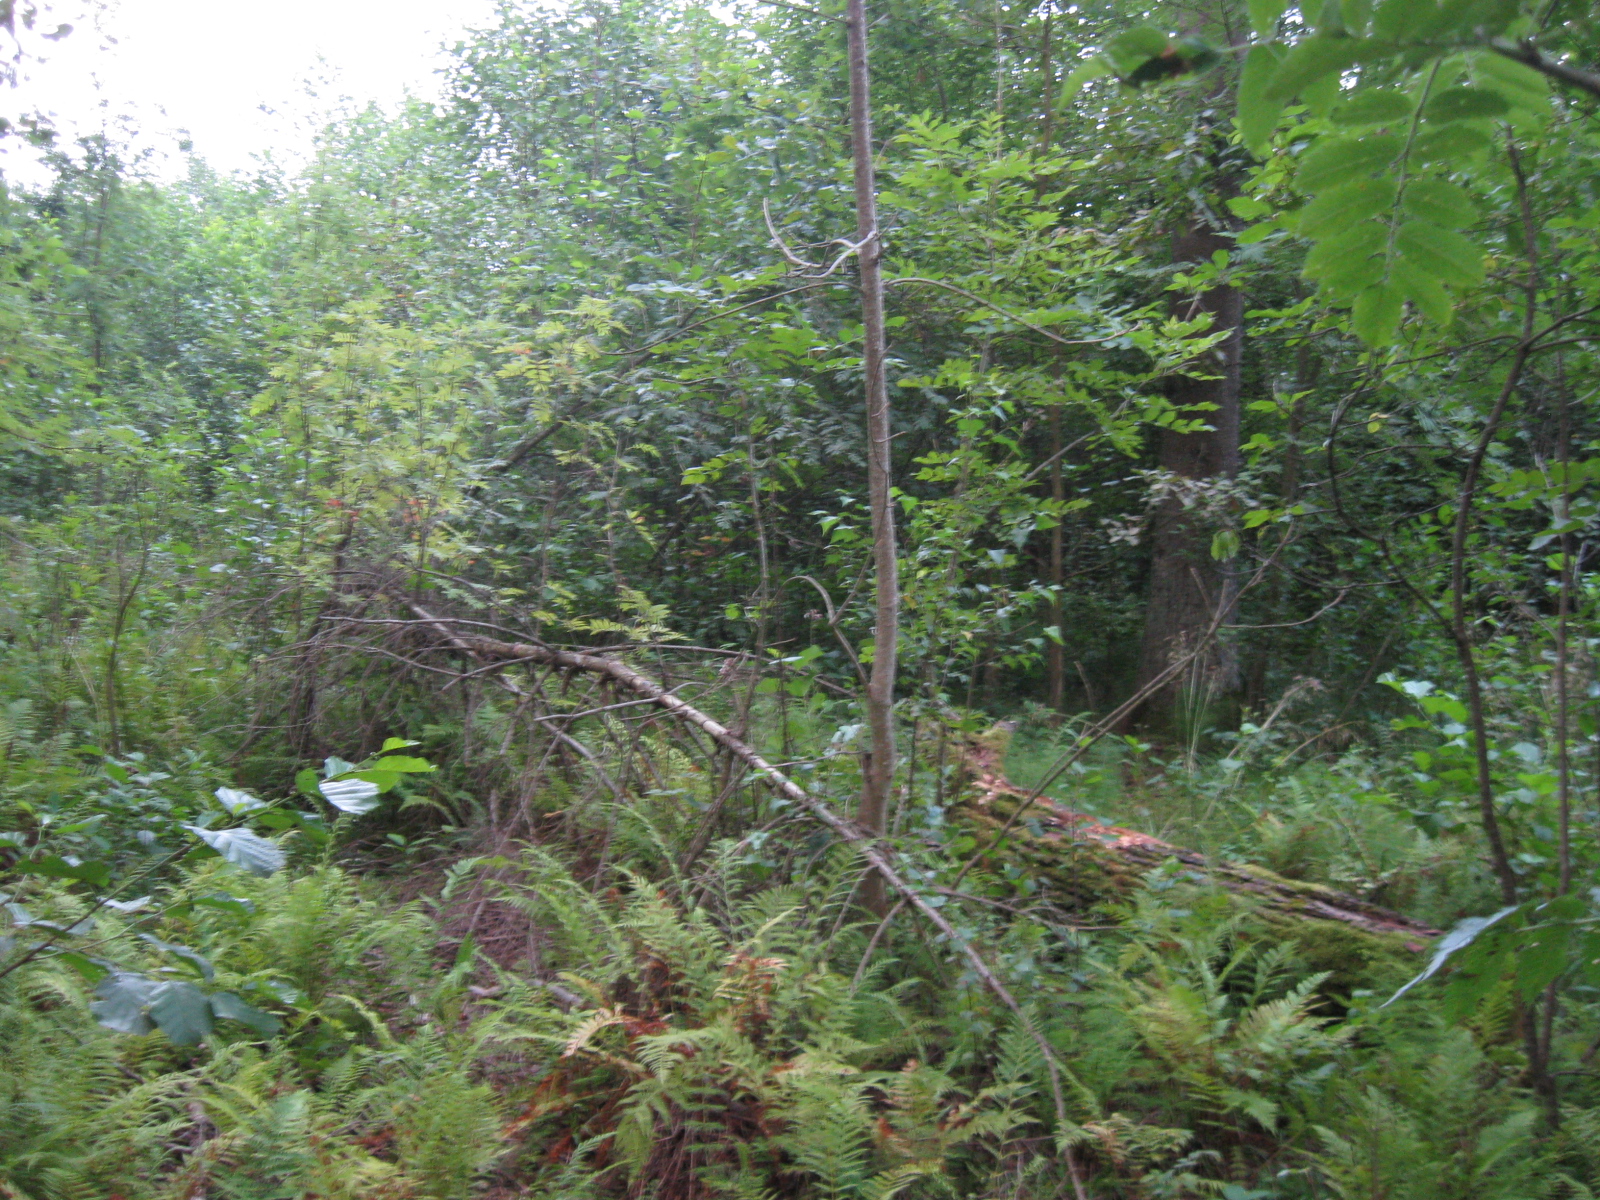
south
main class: Woodland
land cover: Broadleaved woodland
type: non-riverine alder, birch or aspen forest
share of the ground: > 75 %
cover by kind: broadleaved forest trees 80 %, herbaceous plants 15 %, coniferous forest trees 5 %
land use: Forestry
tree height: > 5 m
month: July
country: LT
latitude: 54.7392
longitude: 23.8341
